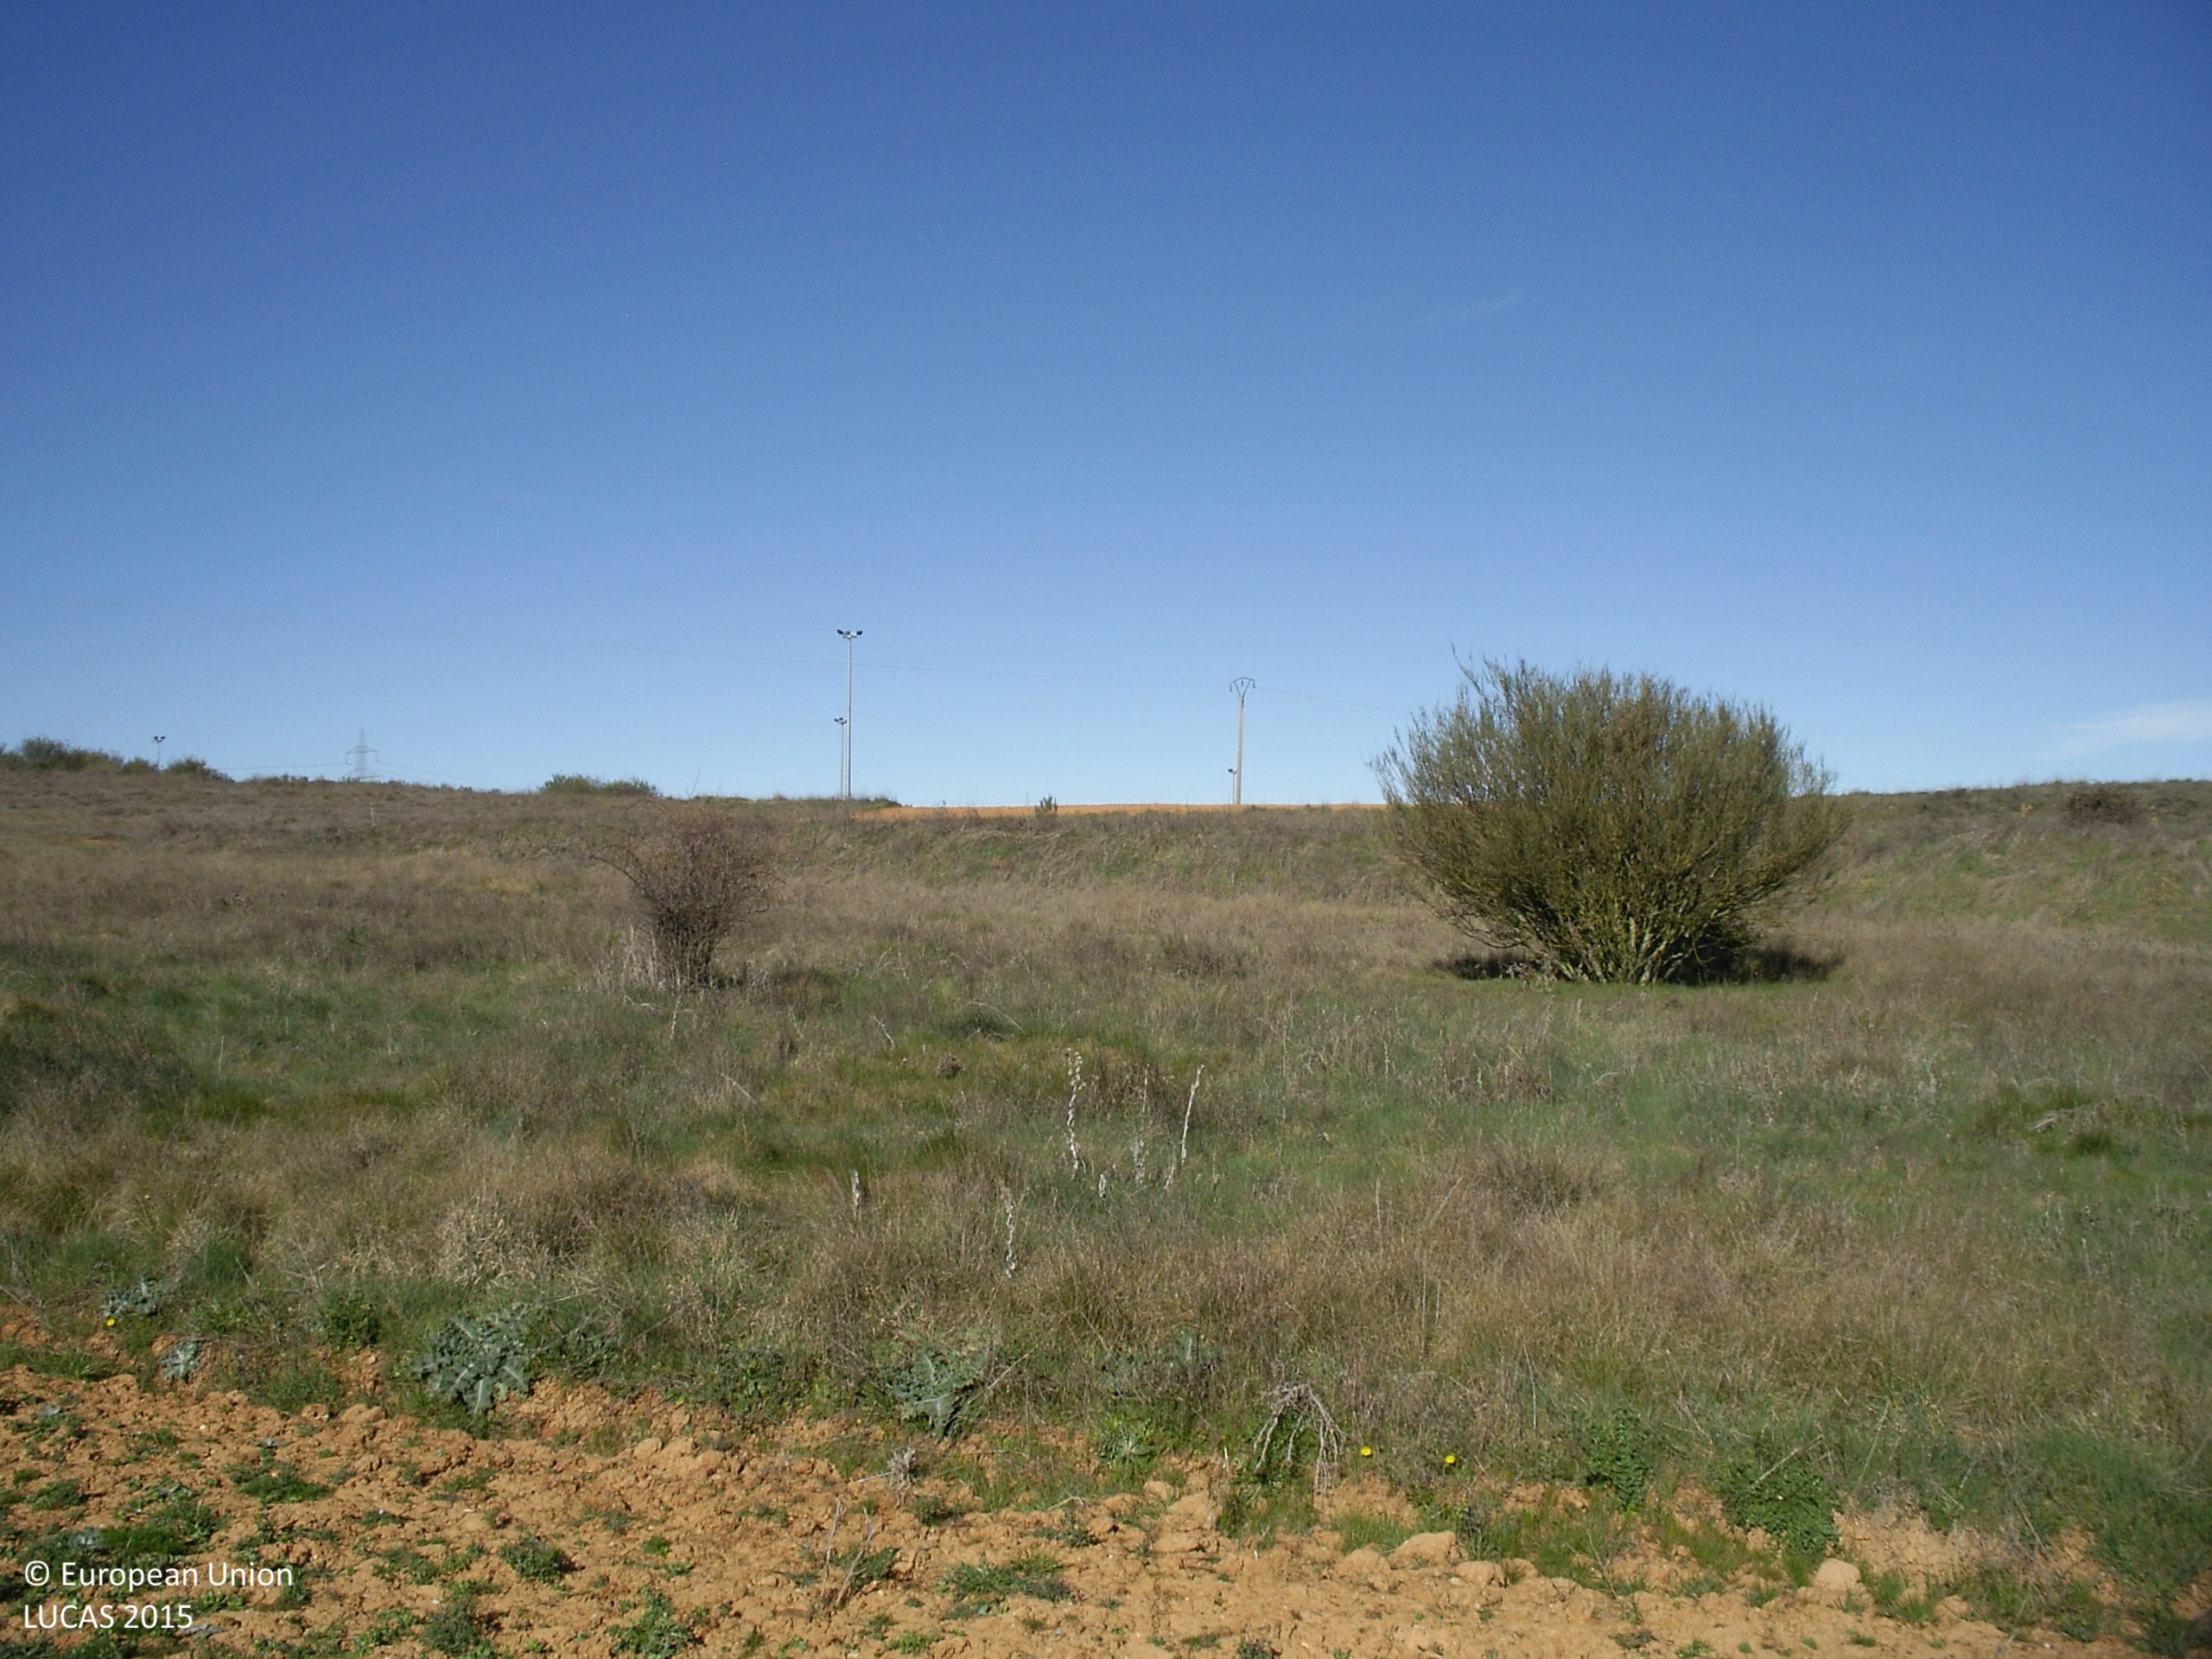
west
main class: Grassland
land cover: Spontaneously vegetated surfaces
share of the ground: > 75 %
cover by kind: consolidated bare surface 60 %, herbaceous plants 40 %
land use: Fallow land
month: March
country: ES
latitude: 42.4454
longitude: -6.0694
